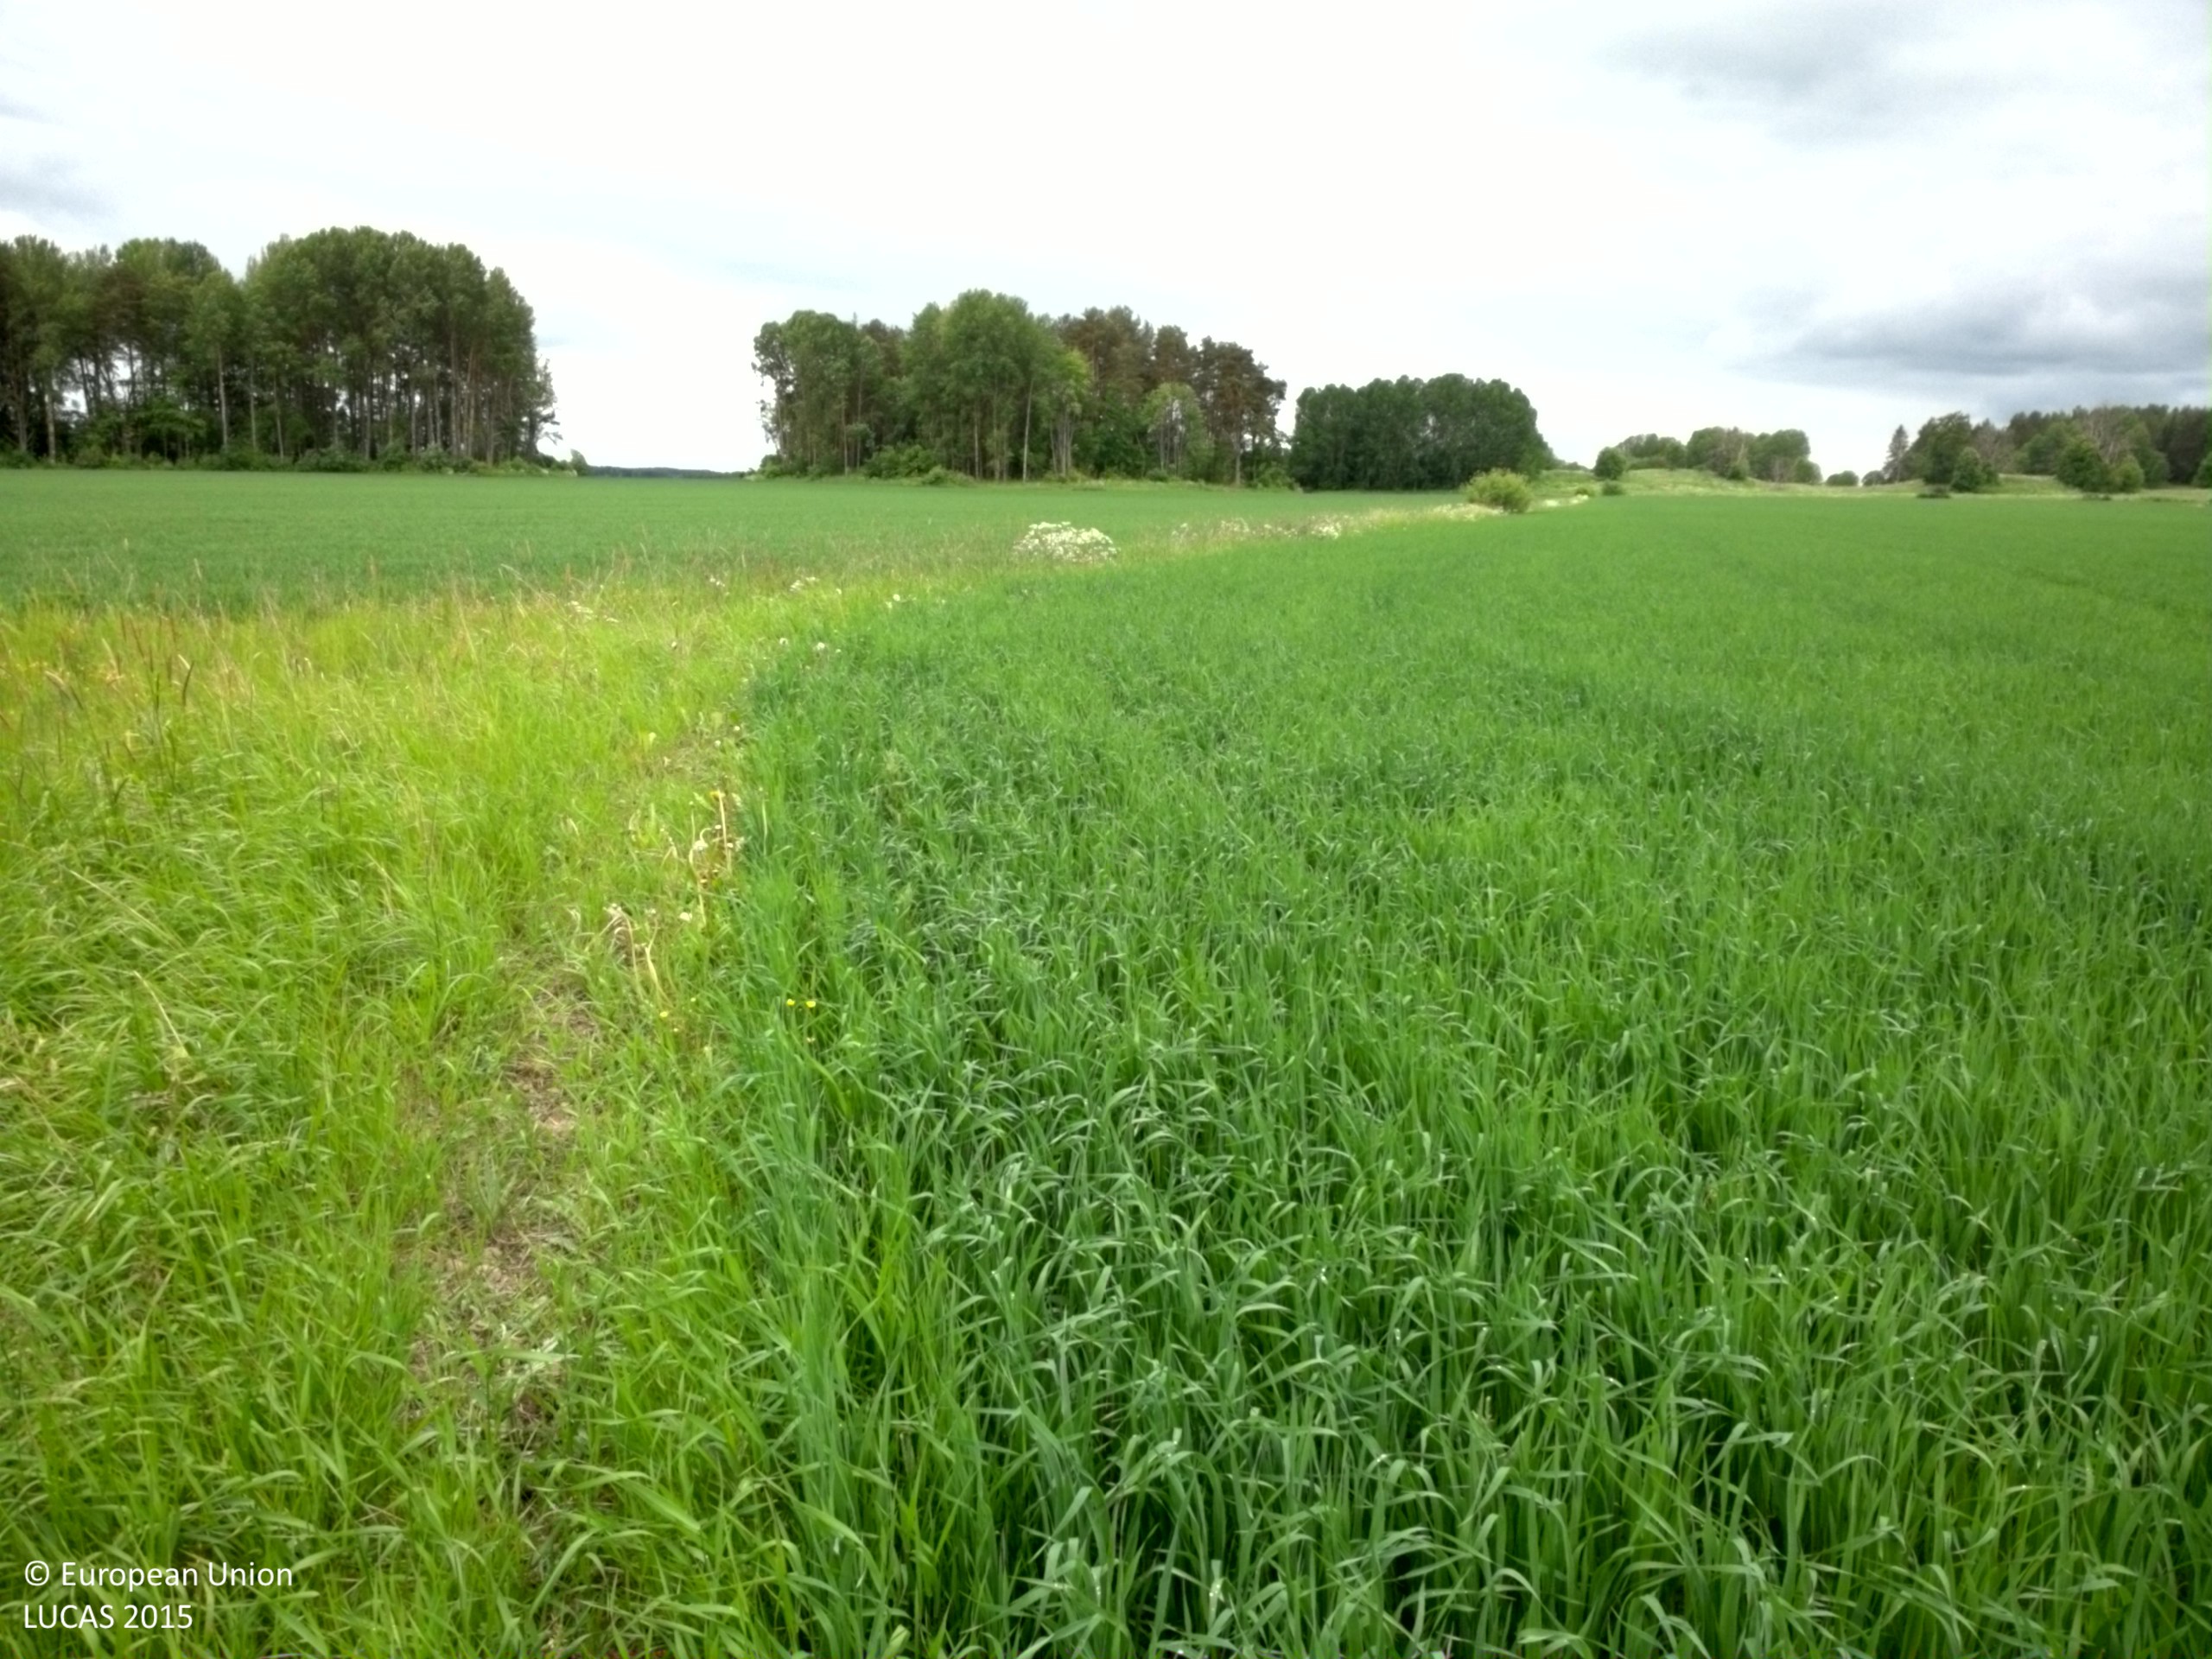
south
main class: Cropland
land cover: Oats
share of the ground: > 75 %
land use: Agriculture (excluding fallow land and kitchen gardens)
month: June
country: SE
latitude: 60.1737
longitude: 17.6173
